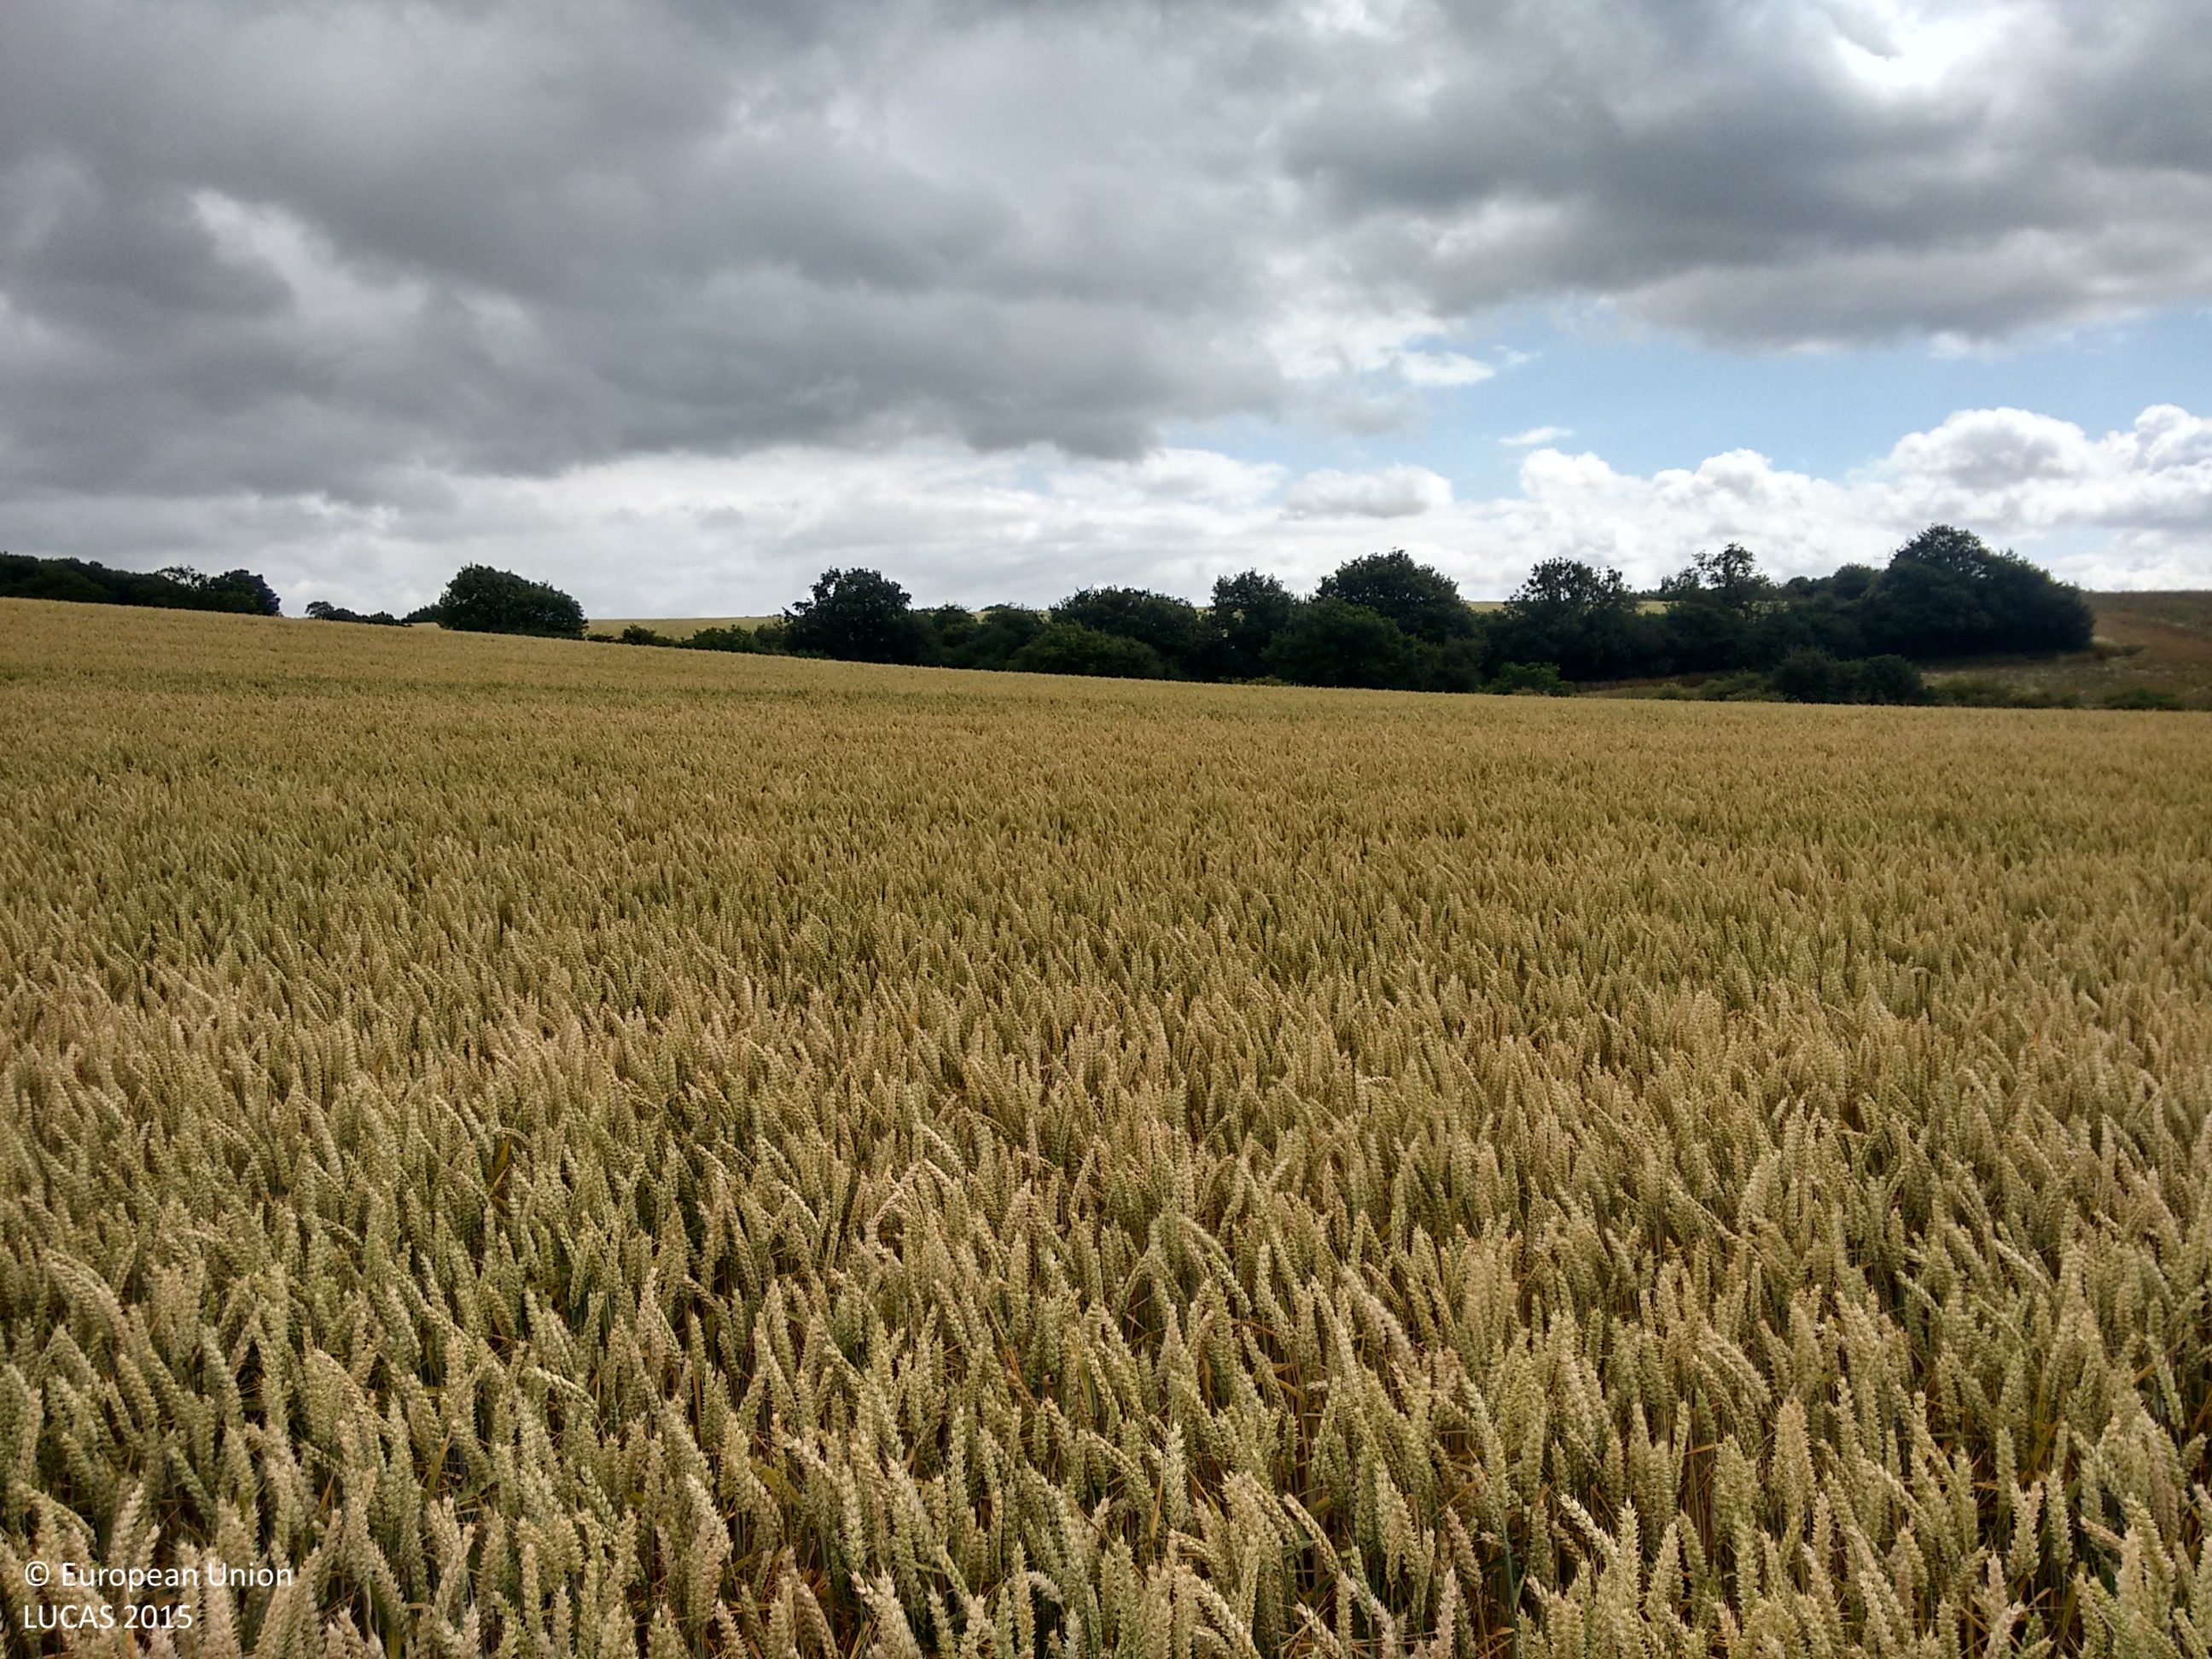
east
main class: Cropland
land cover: Common wheat
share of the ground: > 75 %
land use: Agriculture (excluding fallow land and kitchen gardens)
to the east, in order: Common wheat; Broadleaved woodland; Barley
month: July
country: GB
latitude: 53.1351
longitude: -1.0001
